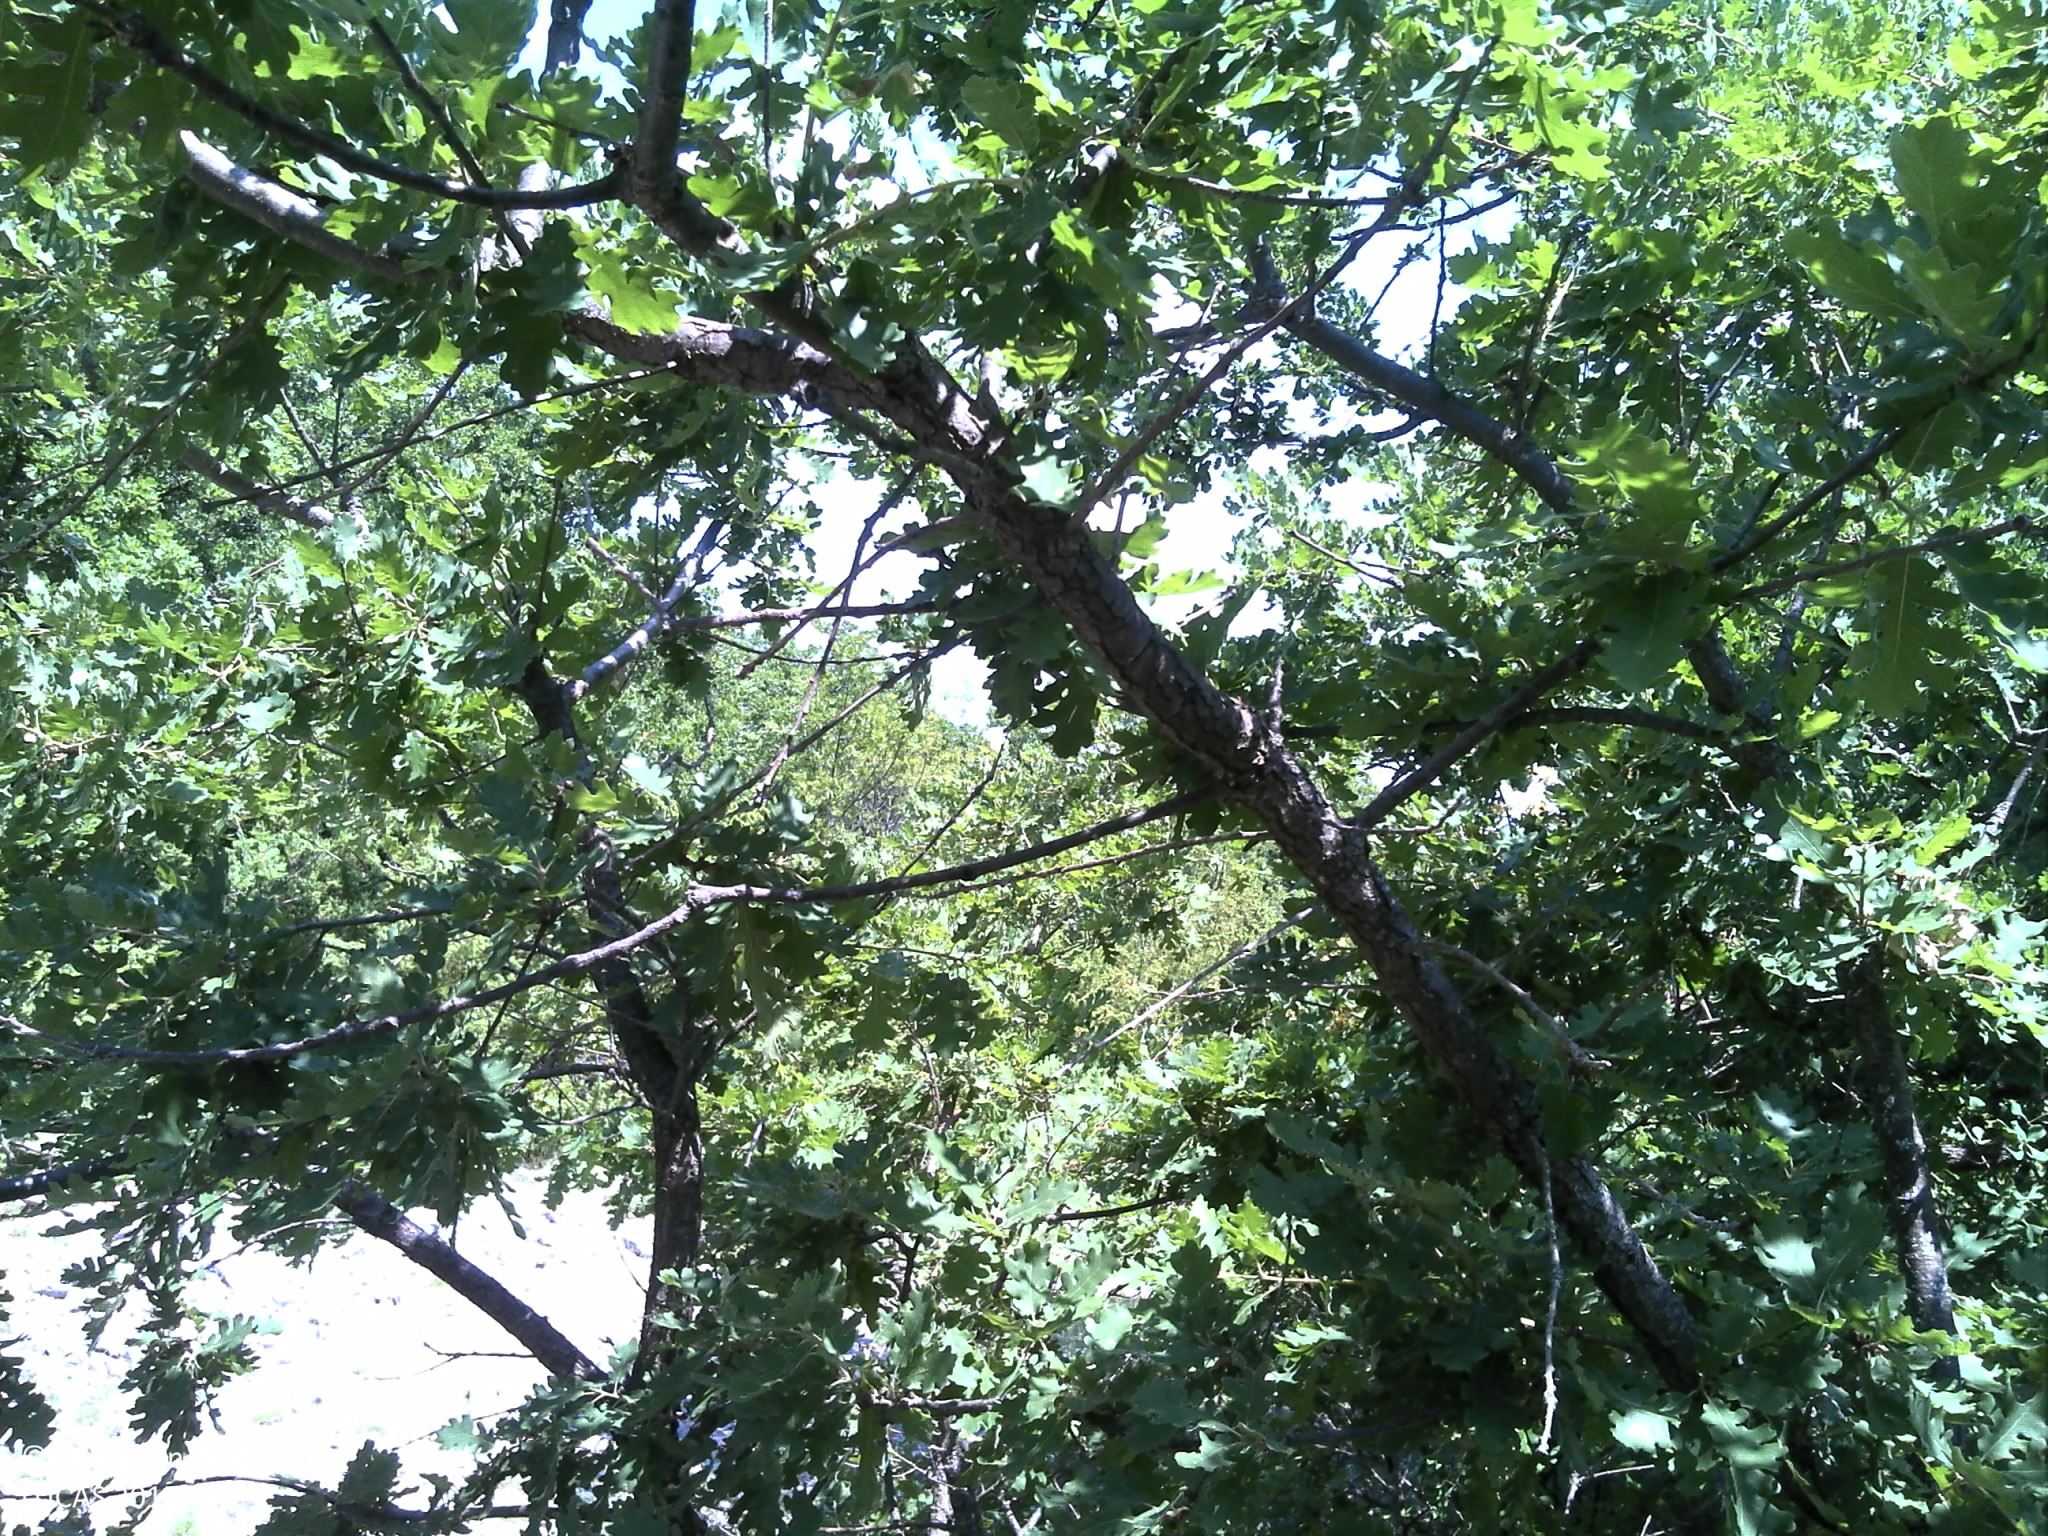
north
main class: Woodland
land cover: Broadleaved woodland
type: thermophilous deciduous forest
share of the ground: 50 - 75 %
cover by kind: broadleaved forest trees 60 %, shrubs 25 %, unconsolidated bare surface 10 %, consolidated bare surface 5 %
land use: Semi-natural and natural areas not in use
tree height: > 5 m
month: June
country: HR
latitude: 43.6015
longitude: 16.2470
